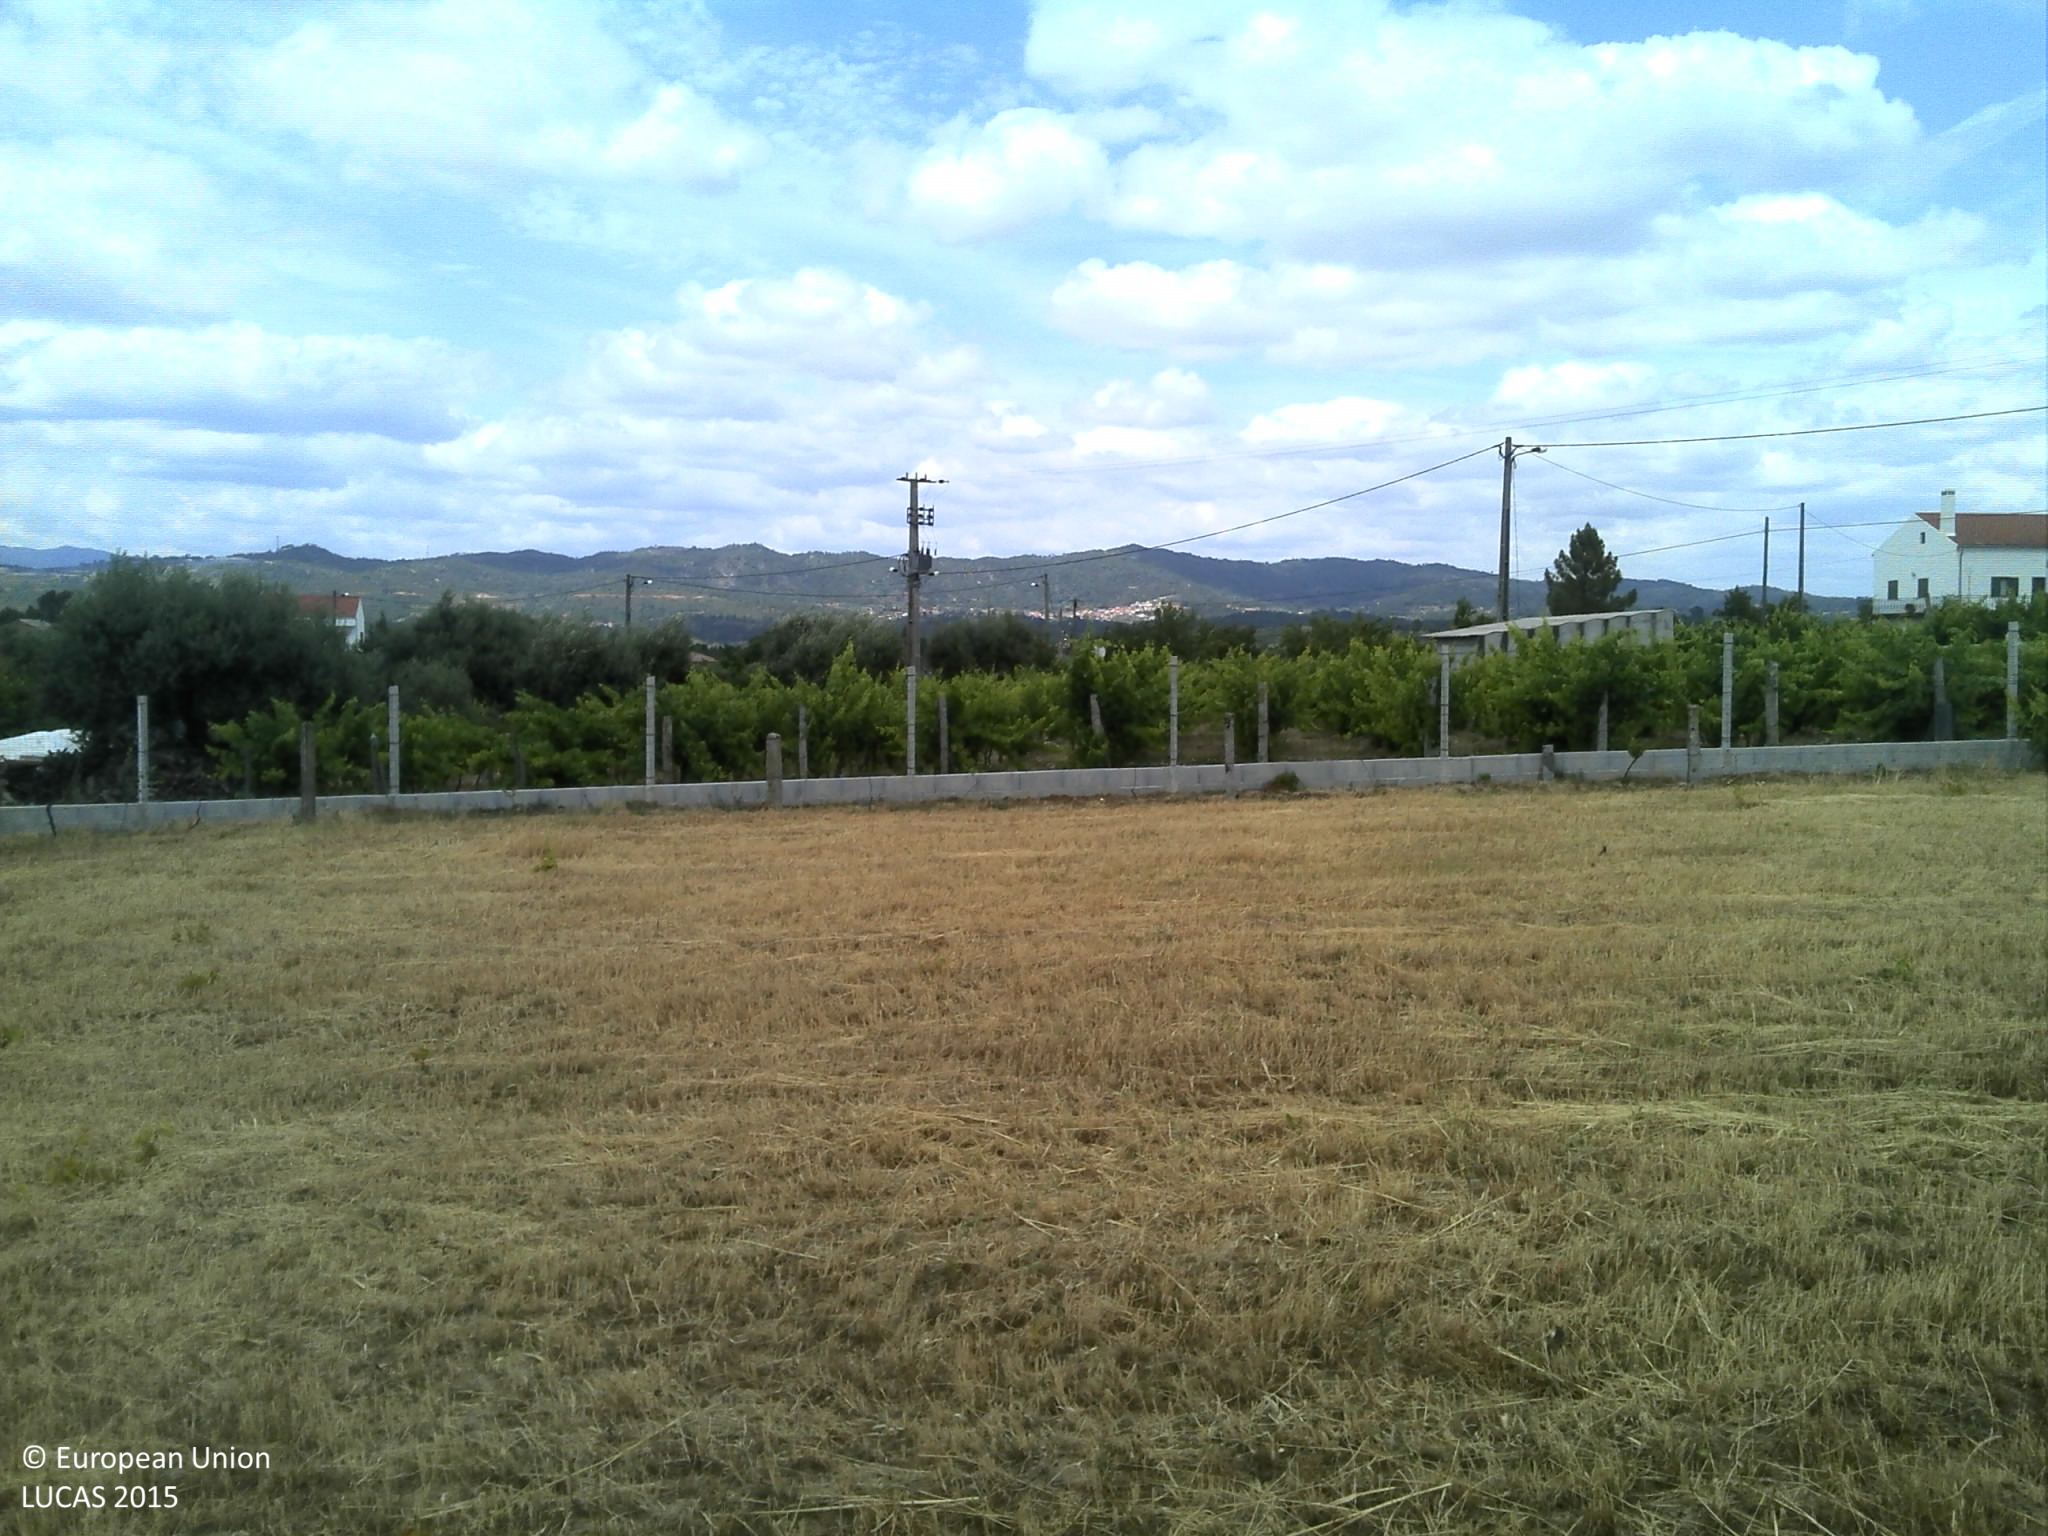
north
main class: Cropland
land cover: Oats
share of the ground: < 10 %
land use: Agriculture (excluding fallow land and kitchen gardens)
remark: Harvested field
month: June
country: PT
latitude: 40.1627
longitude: -7.4697
